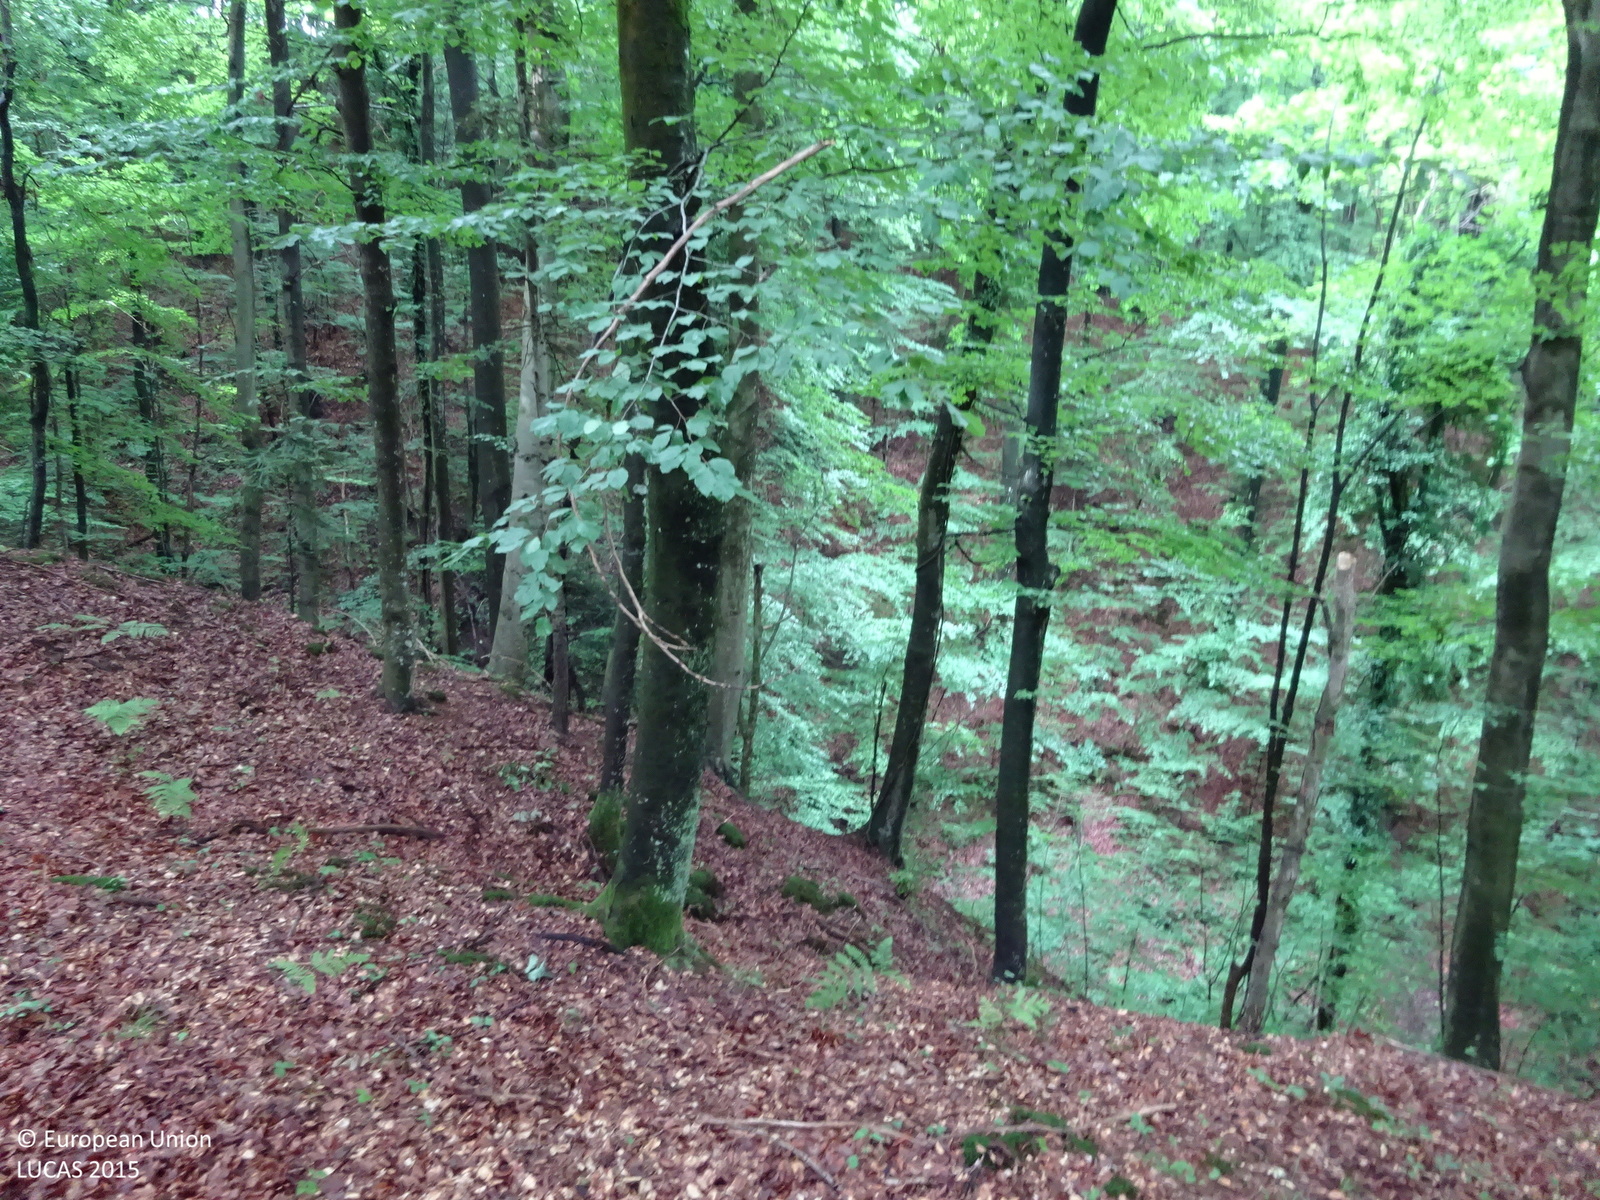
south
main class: Woodland
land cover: Broadleaved woodland
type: mountainous beech forest
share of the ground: > 75 %
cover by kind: broadleaved forest trees 90 %, unconsolidated bare surface 10 %
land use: Forestry
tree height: > 5 m
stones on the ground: < 10 %
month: June
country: AT
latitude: 46.7008
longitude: 15.4266
